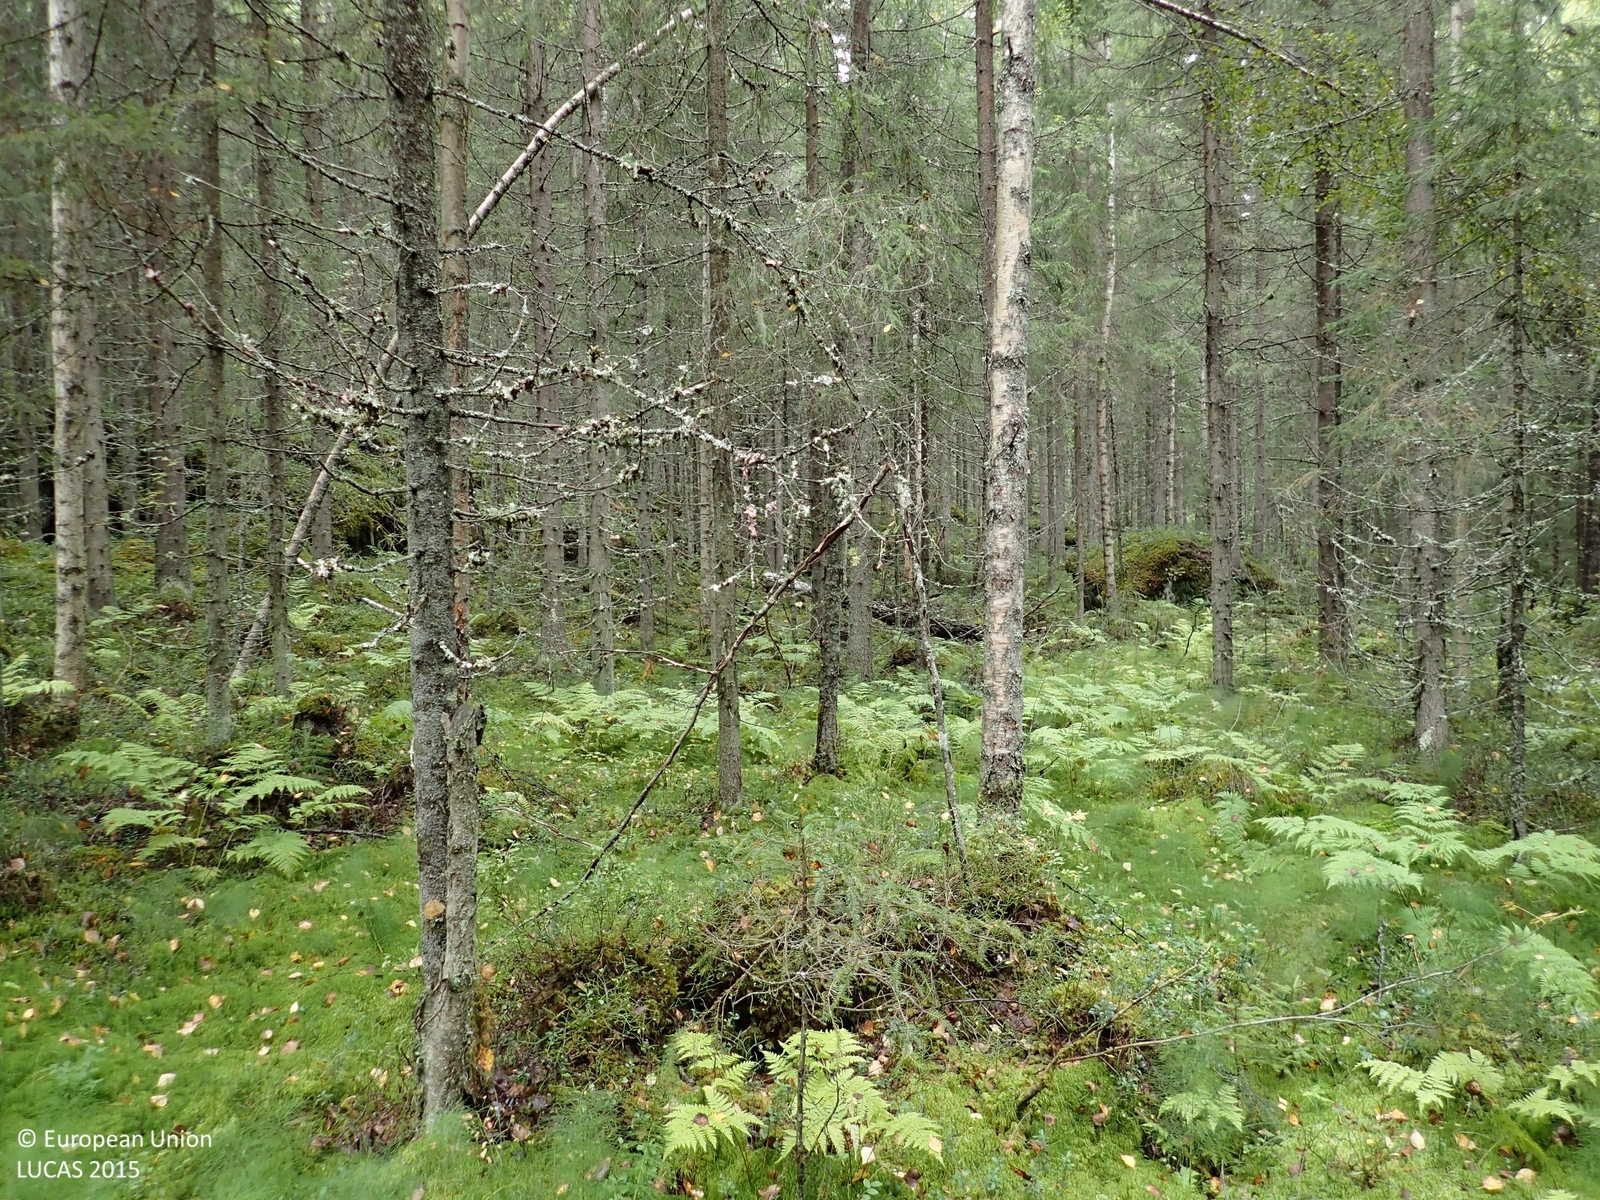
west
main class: Woodland
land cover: Spruce dominated coniferous woodland
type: mire and swamp forests
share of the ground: > 75 %
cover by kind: coniferous forest trees 65 %, broadleaved forest trees 10 %, shrubs 10 %, lichens and mosses 10 %, herbaceous plants 5 %
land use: Forestry
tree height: > 5 m
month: September
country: FI
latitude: 63.0988
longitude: 25.9858
